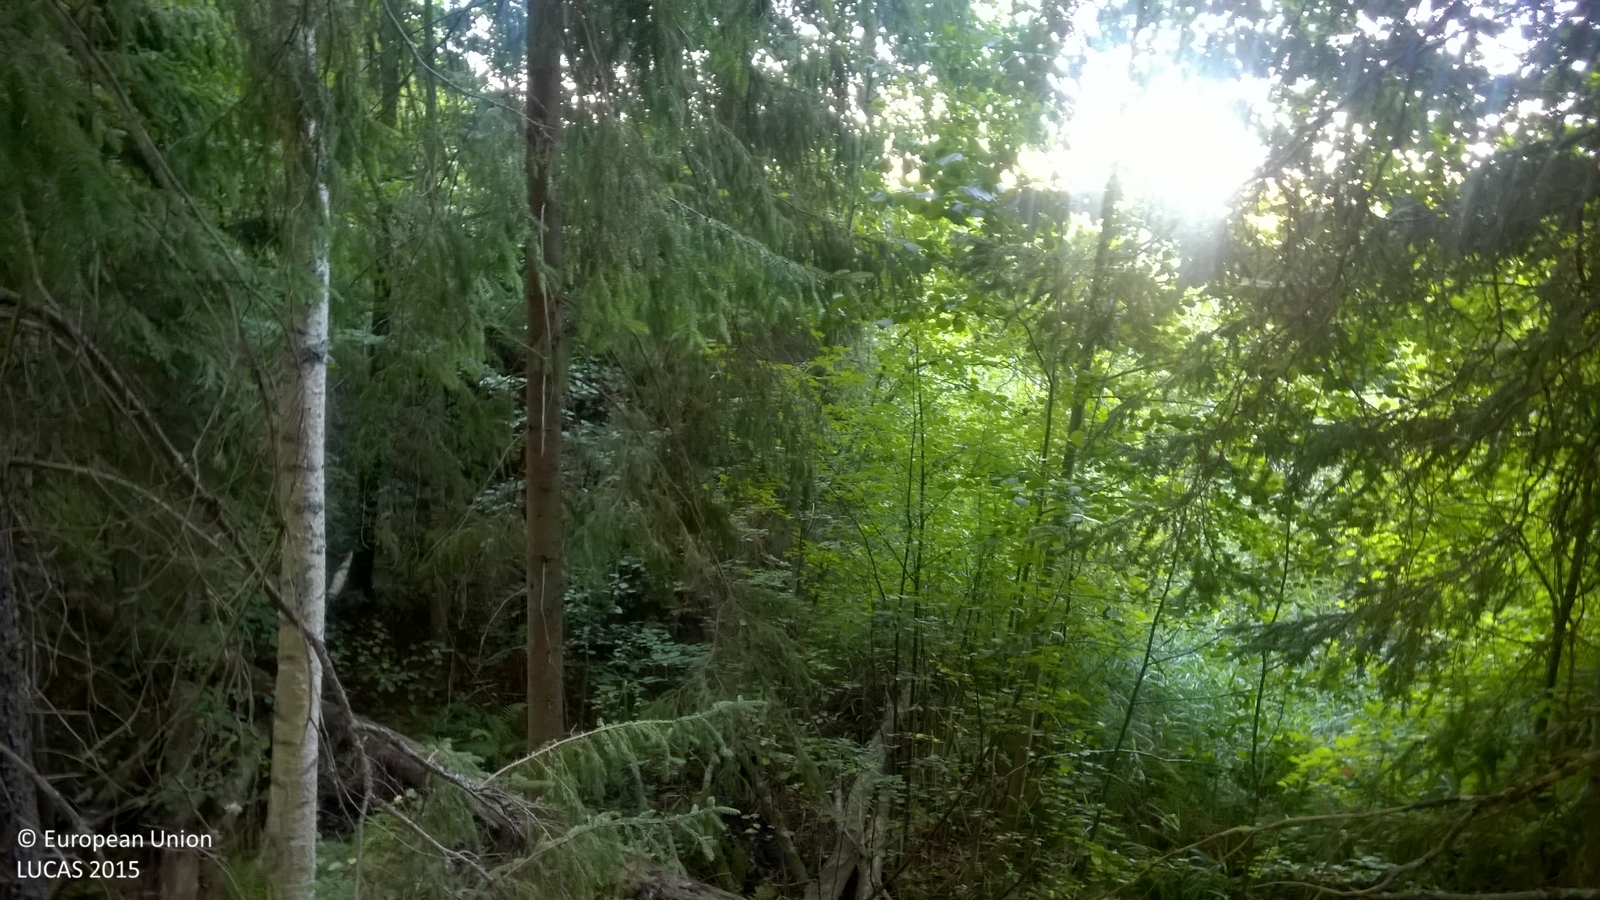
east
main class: Woodland
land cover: Other mixed woodland
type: hemiboreal forest and nemoral coniferous forest and mixed broadleaved-coniferous forest
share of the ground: > 75 %
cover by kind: coniferous forest trees 50 %, broadleaved forest trees 35 %, herbaceous plants 5 %, lichens and mosses 5 %, unconsolidated bare surface 5 %
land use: Forestry
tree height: > 5 m
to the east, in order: Other mixed woodland; Broadleaved woodland; Inland marshes; Broadleaved woodland; Spruce dominated mixed woodland; Spontaneously vegetated surfaces; Broadleaved woodland
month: August
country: LV
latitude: 57.7046
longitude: 26.0541
